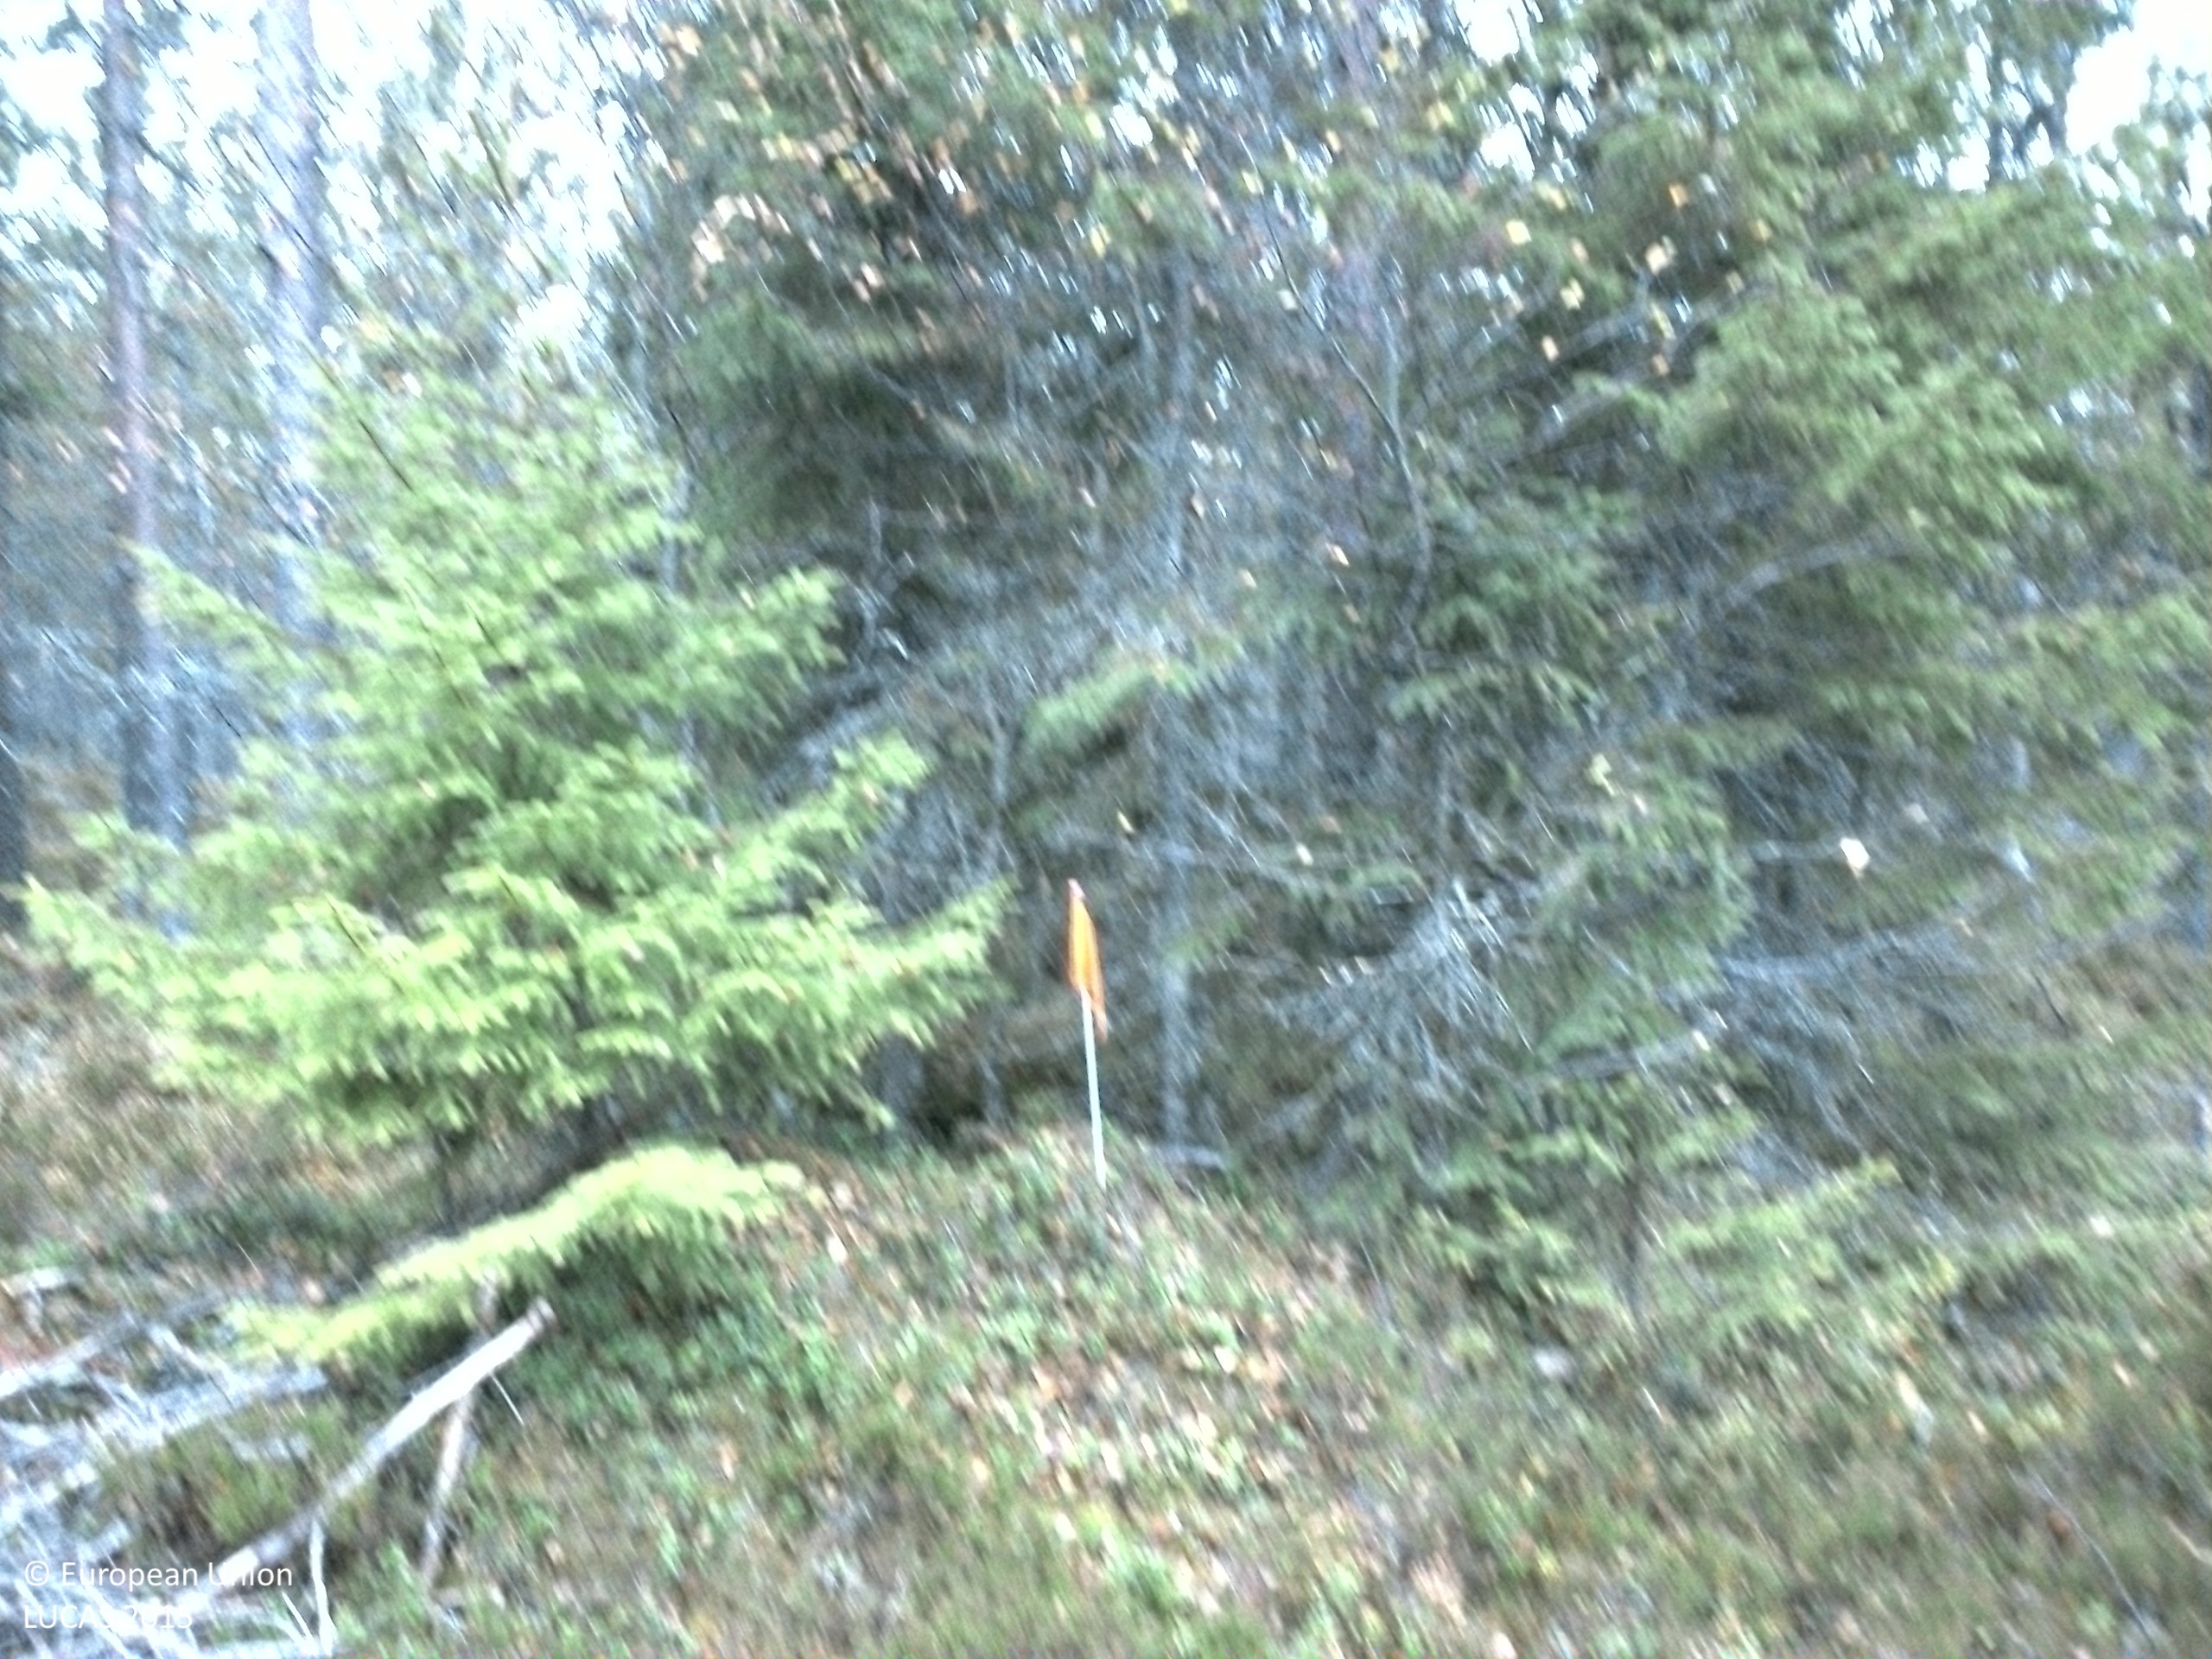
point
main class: Woodland
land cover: Spruce dominated mixed woodland
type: boreal forest
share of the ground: 25 - 50 %
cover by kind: coniferous forest trees 30 %, shrubs 30 %, consolidated bare surface 25 %, broadleaved forest trees 15 %
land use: Forestry
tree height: > 5 m
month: October
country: SE
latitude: 61.3246
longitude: 14.2642
